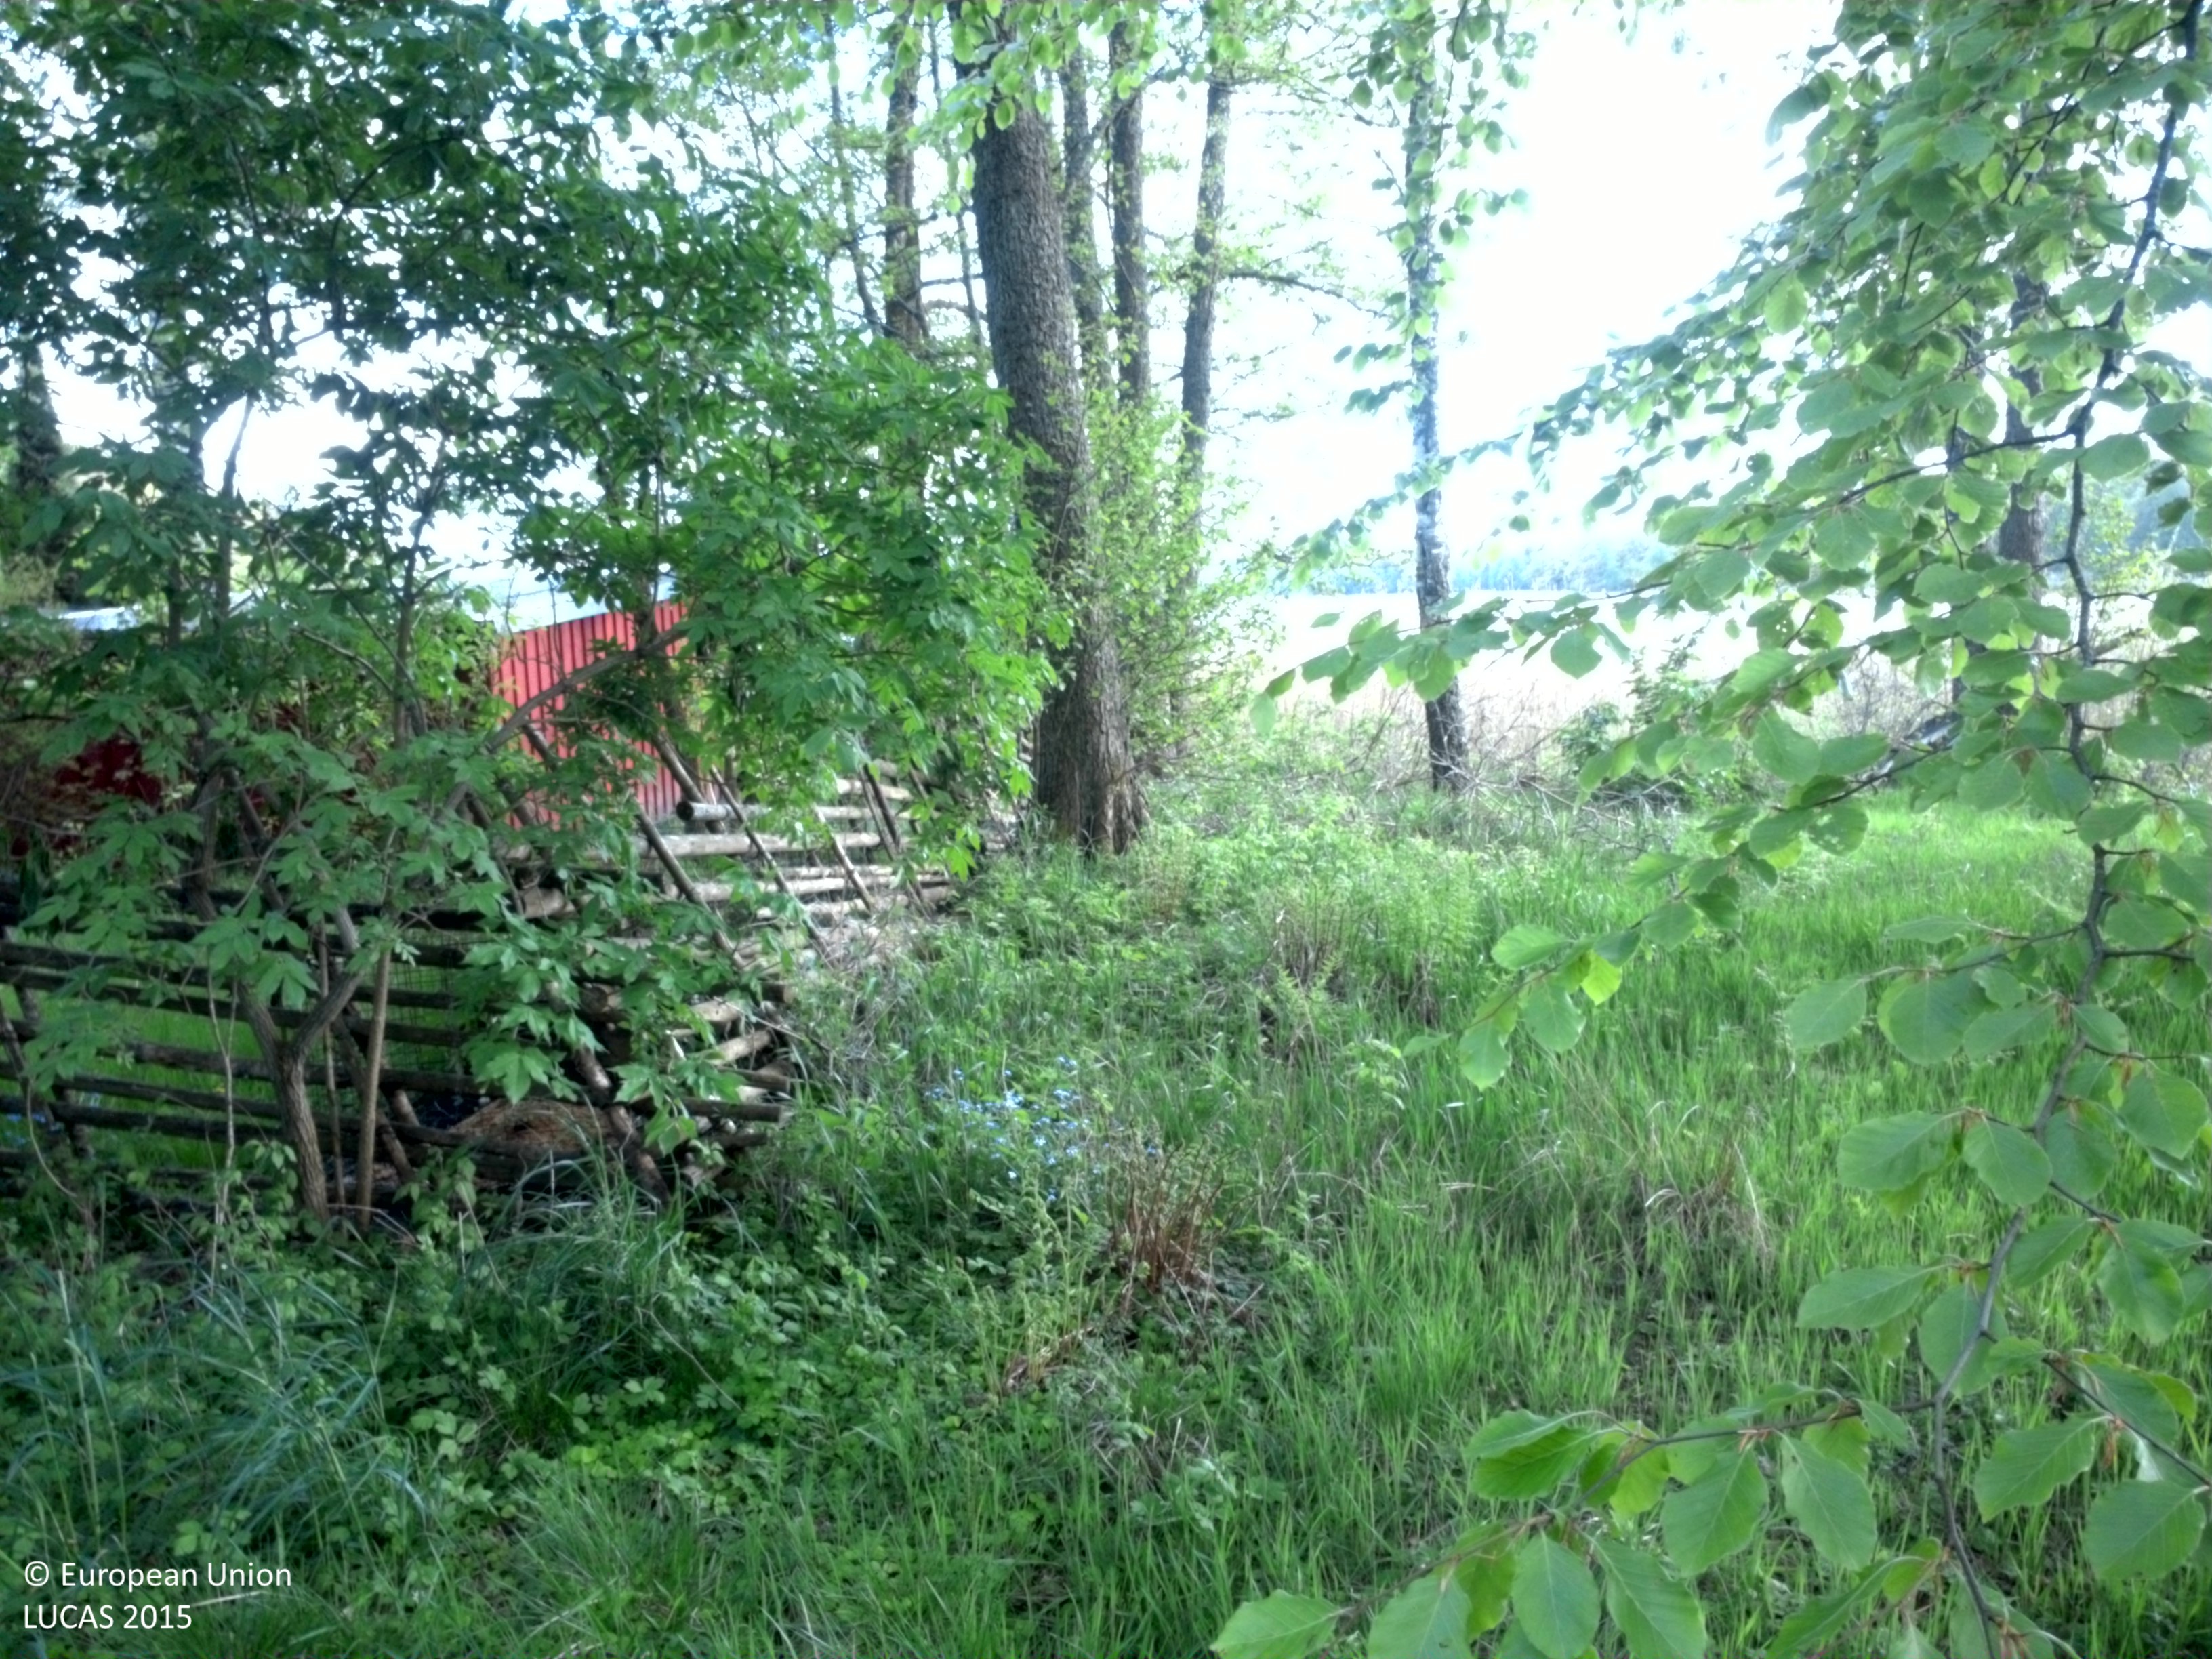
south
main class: Woodland
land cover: Broadleaved woodland
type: boreal forest
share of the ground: 50 - 75 %
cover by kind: broadleaved forest trees 60 %, herbaceous plants 30 %, coniferous forest trees 10 %
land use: Forestry
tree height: > 5 m
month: May
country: SE
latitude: 56.6990
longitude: 14.6189
